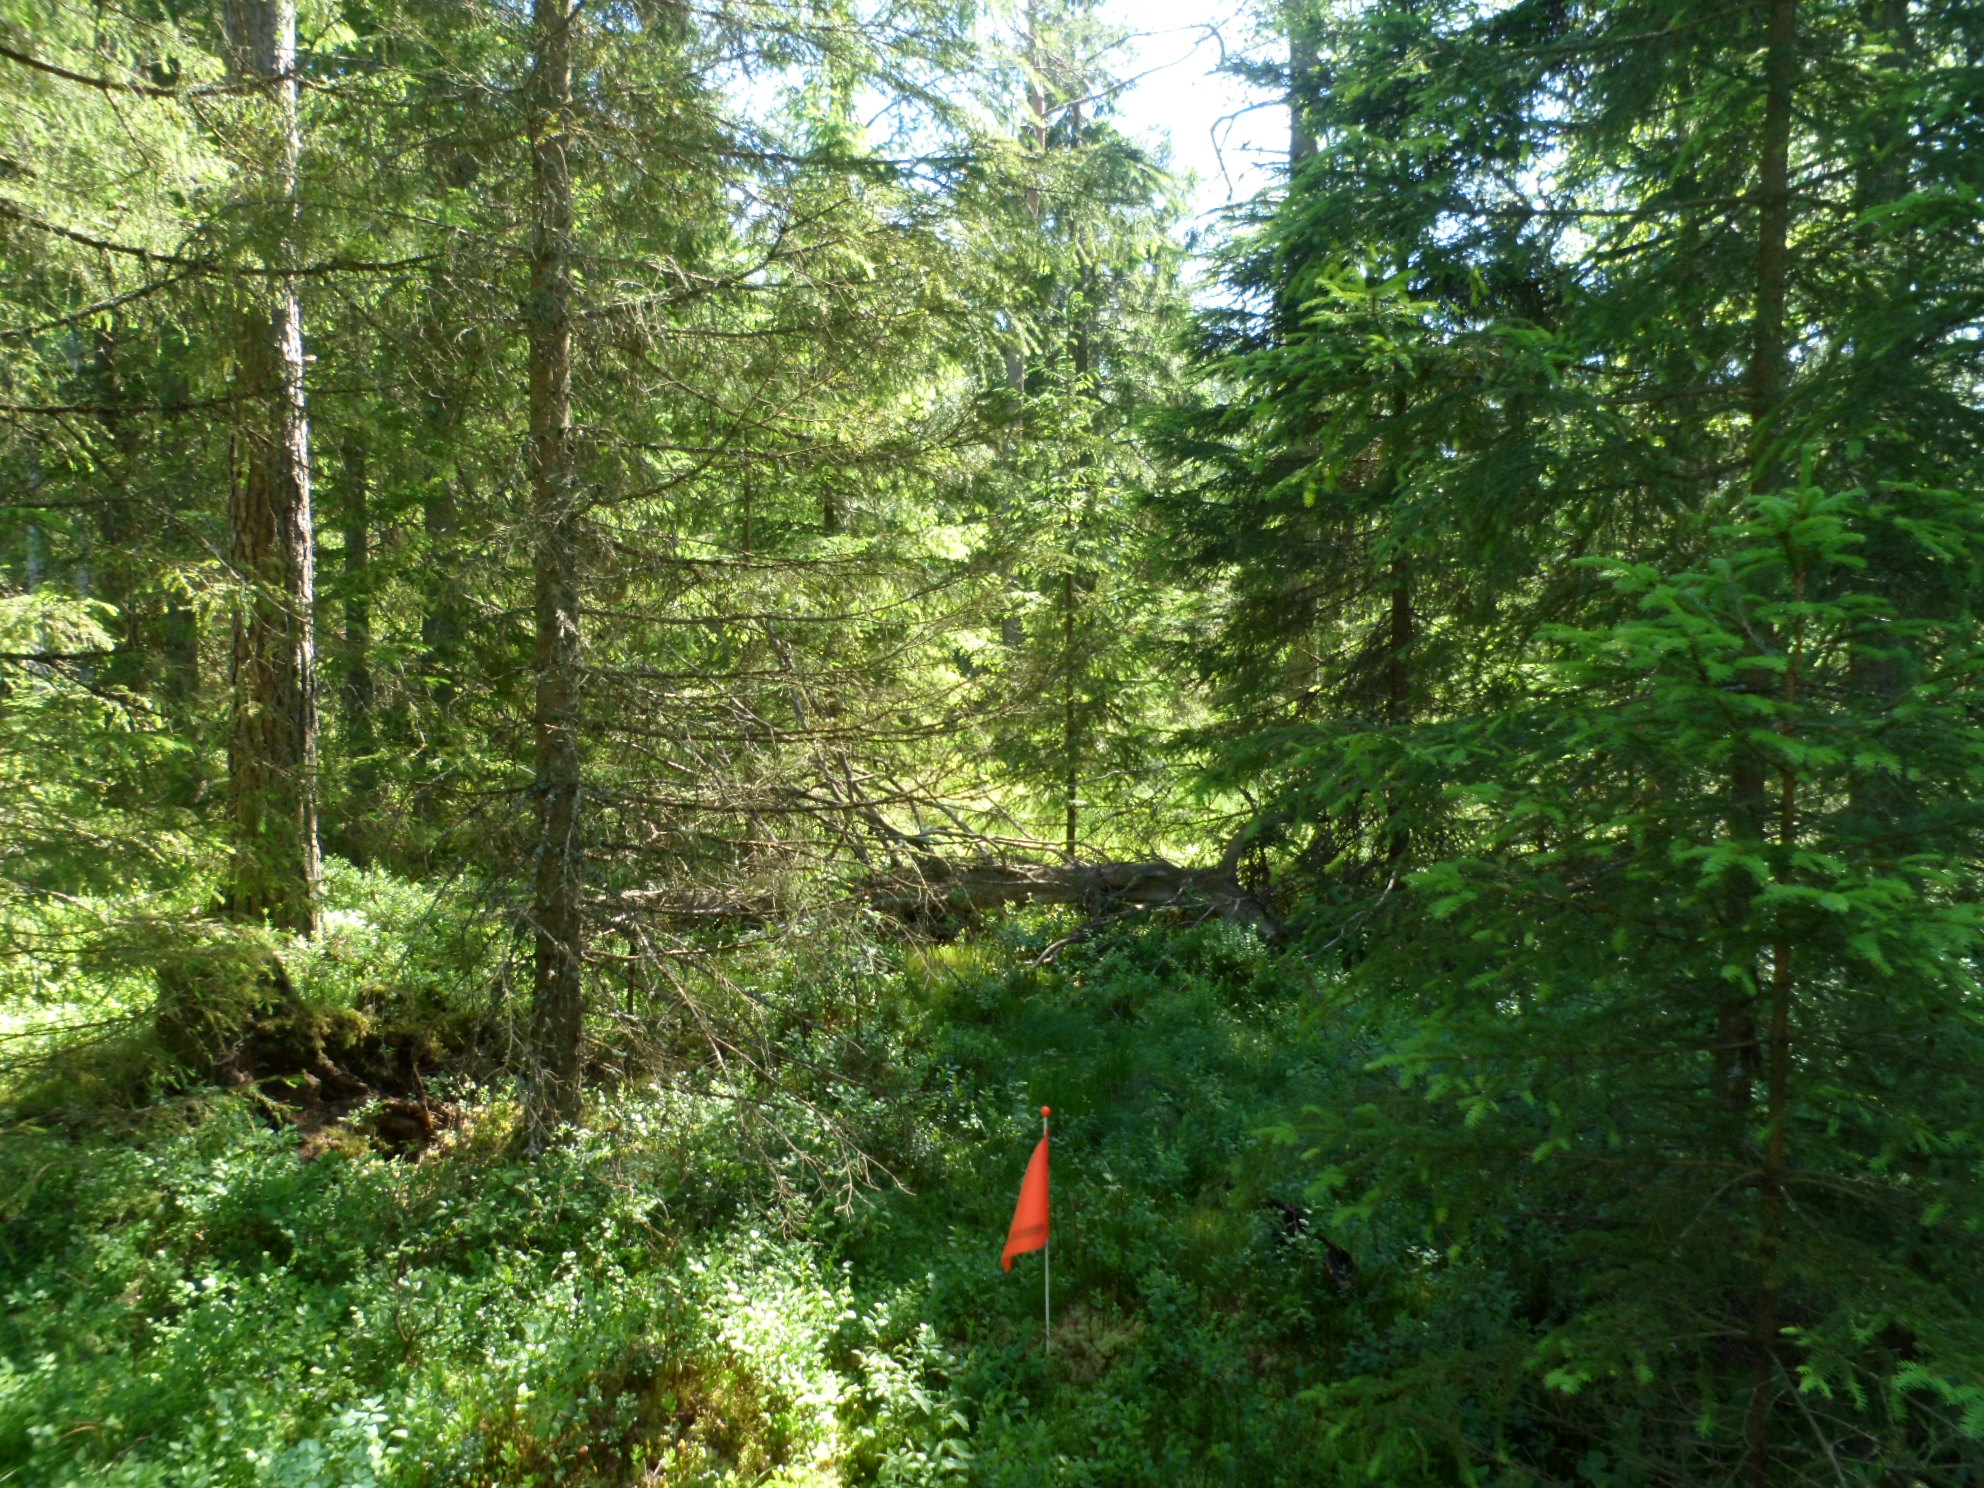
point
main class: Woodland
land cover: Spruce dominated coniferous woodland
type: boreal forest
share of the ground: 50 - 75 %
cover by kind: coniferous forest trees 50 %, shrubs 30 %, lichens and mosses 10 %, broadleaved forest trees 5 %, herbaceous plants 5 %
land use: Forestry
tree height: > 5 m
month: July
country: SE
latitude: 57.4940
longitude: 14.5506
